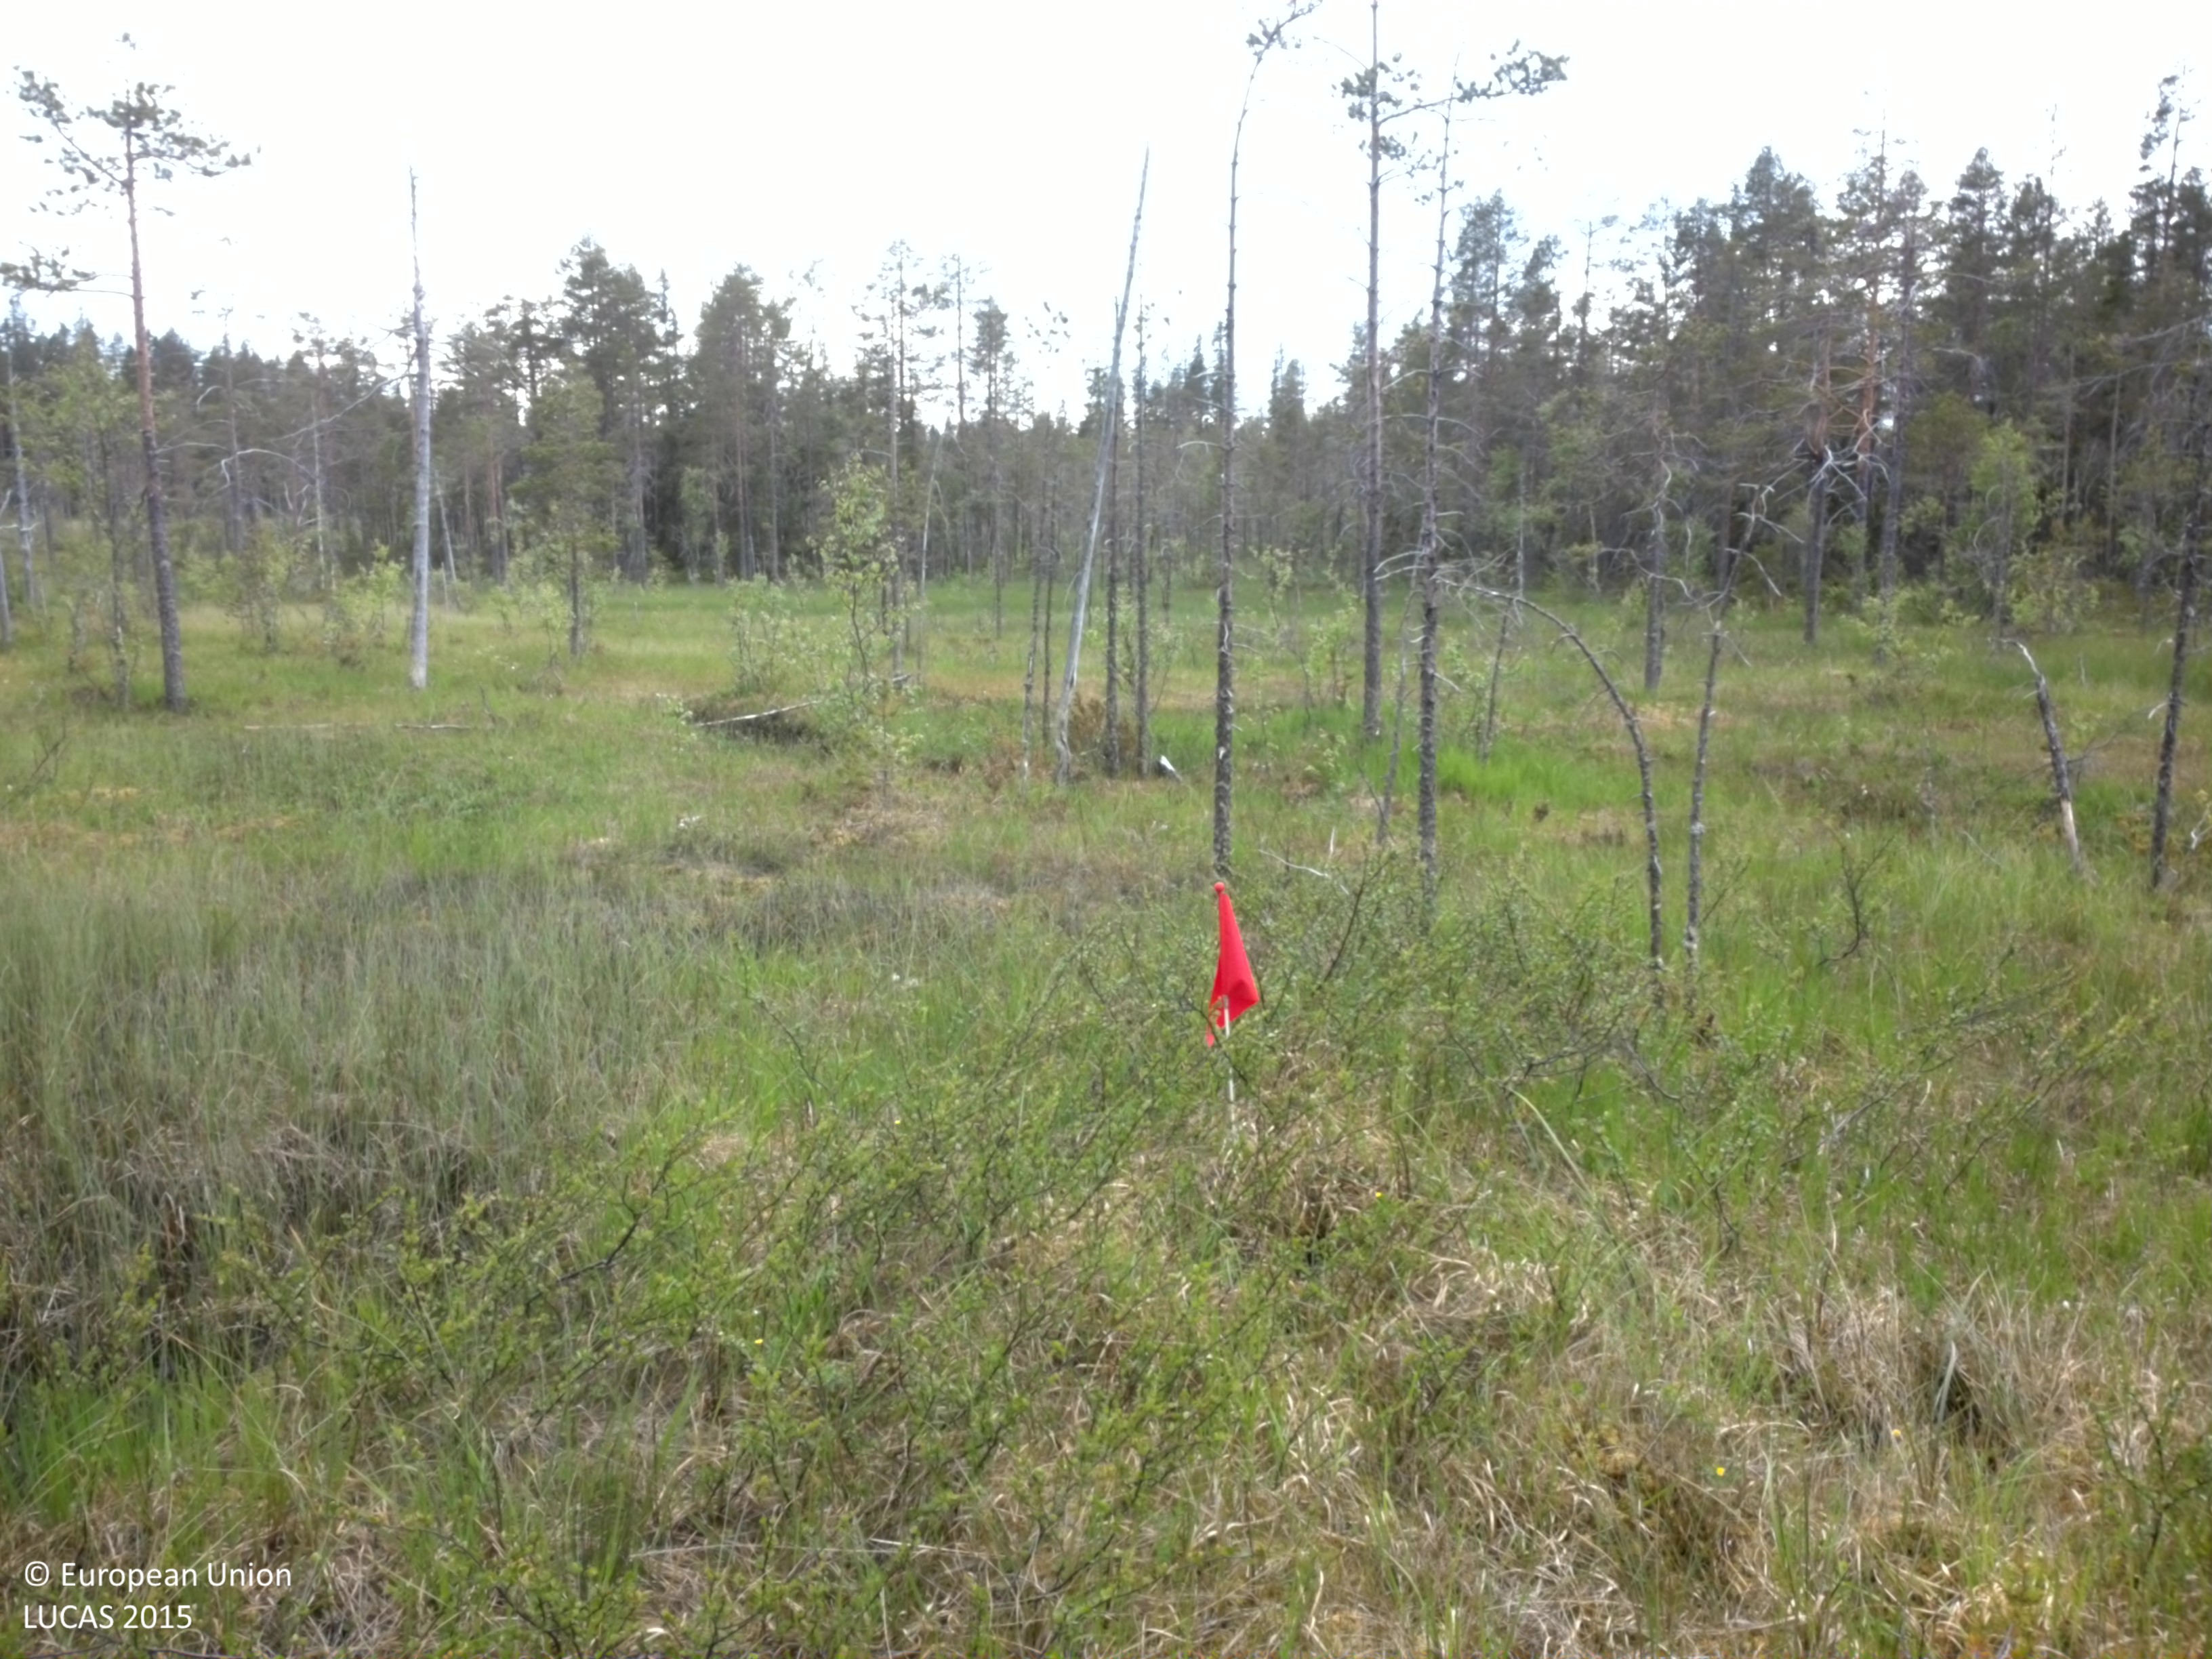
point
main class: Woodland
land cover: Pine dominated coniferous woodland
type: mire and swamp forests
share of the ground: 10 - 25 %
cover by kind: herbaceous plants 45 %, shrubs 25 %, coniferous forest trees 20 %, broadleaved forest trees 5 %, lichens and mosses 5 %
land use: Semi-natural and natural areas not in use
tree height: < 5 m
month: July
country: SE
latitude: 64.4128
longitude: 20.7921
